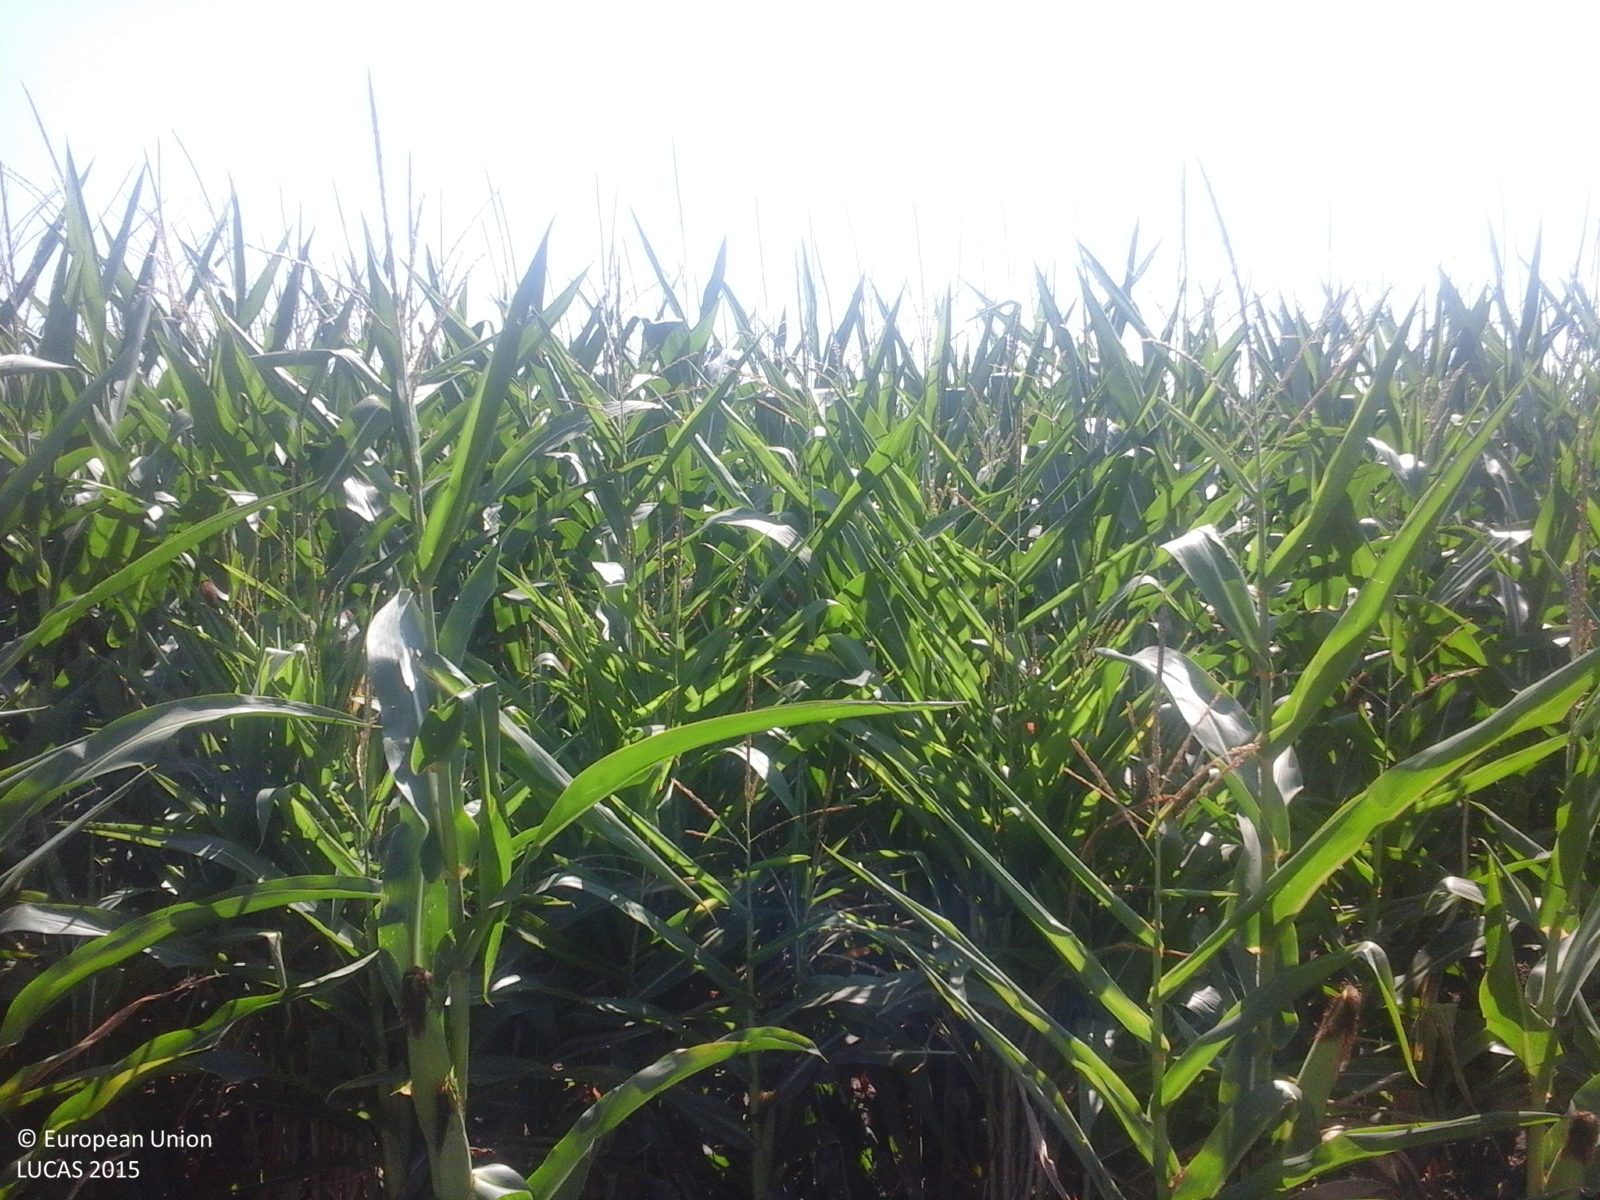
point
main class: Cropland
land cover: Maize
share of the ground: > 75 %
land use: Agriculture (excluding fallow land and kitchen gardens)
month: July
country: RO
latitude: 44.8276
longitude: 27.5648
